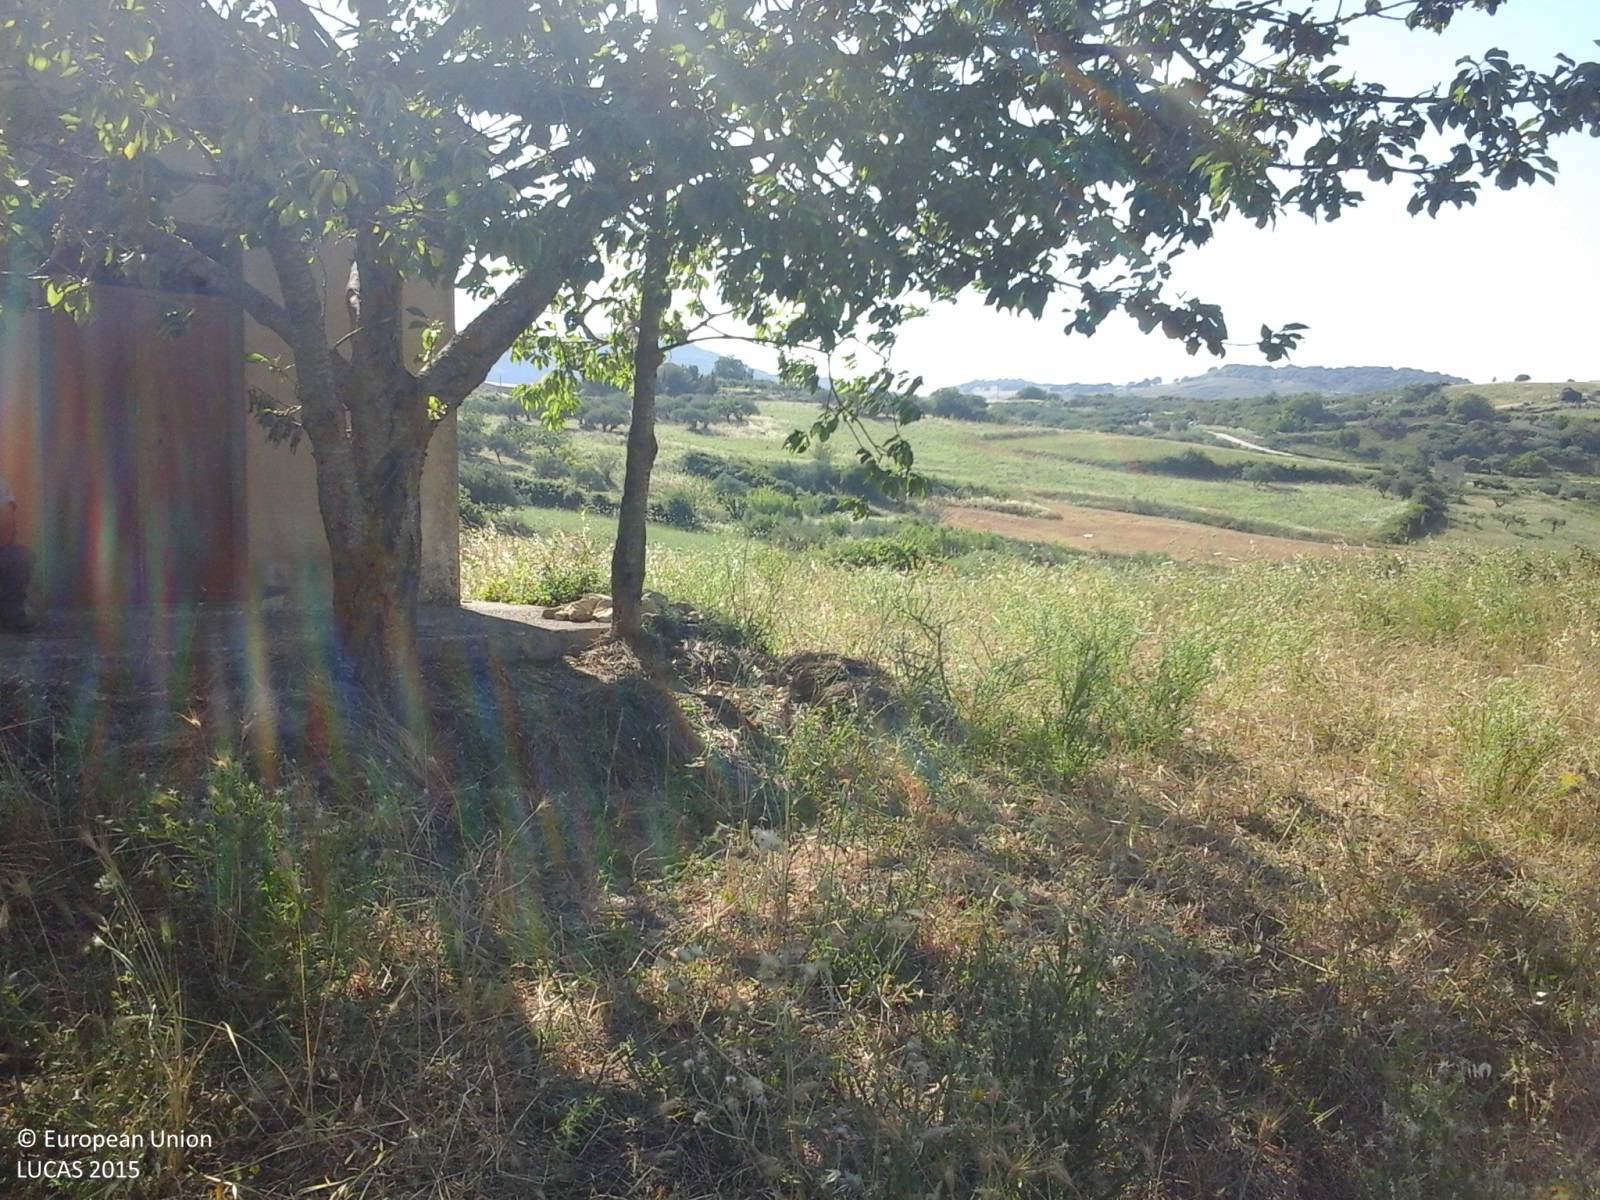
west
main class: Cropland
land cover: Olive groves
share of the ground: 25 - 50 %
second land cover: Spontaneously vegetated surfaces
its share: > 75 %
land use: Agriculture (excluding fallow land and kitchen gardens)
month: July
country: IT
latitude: 37.6927
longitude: 13.2307
